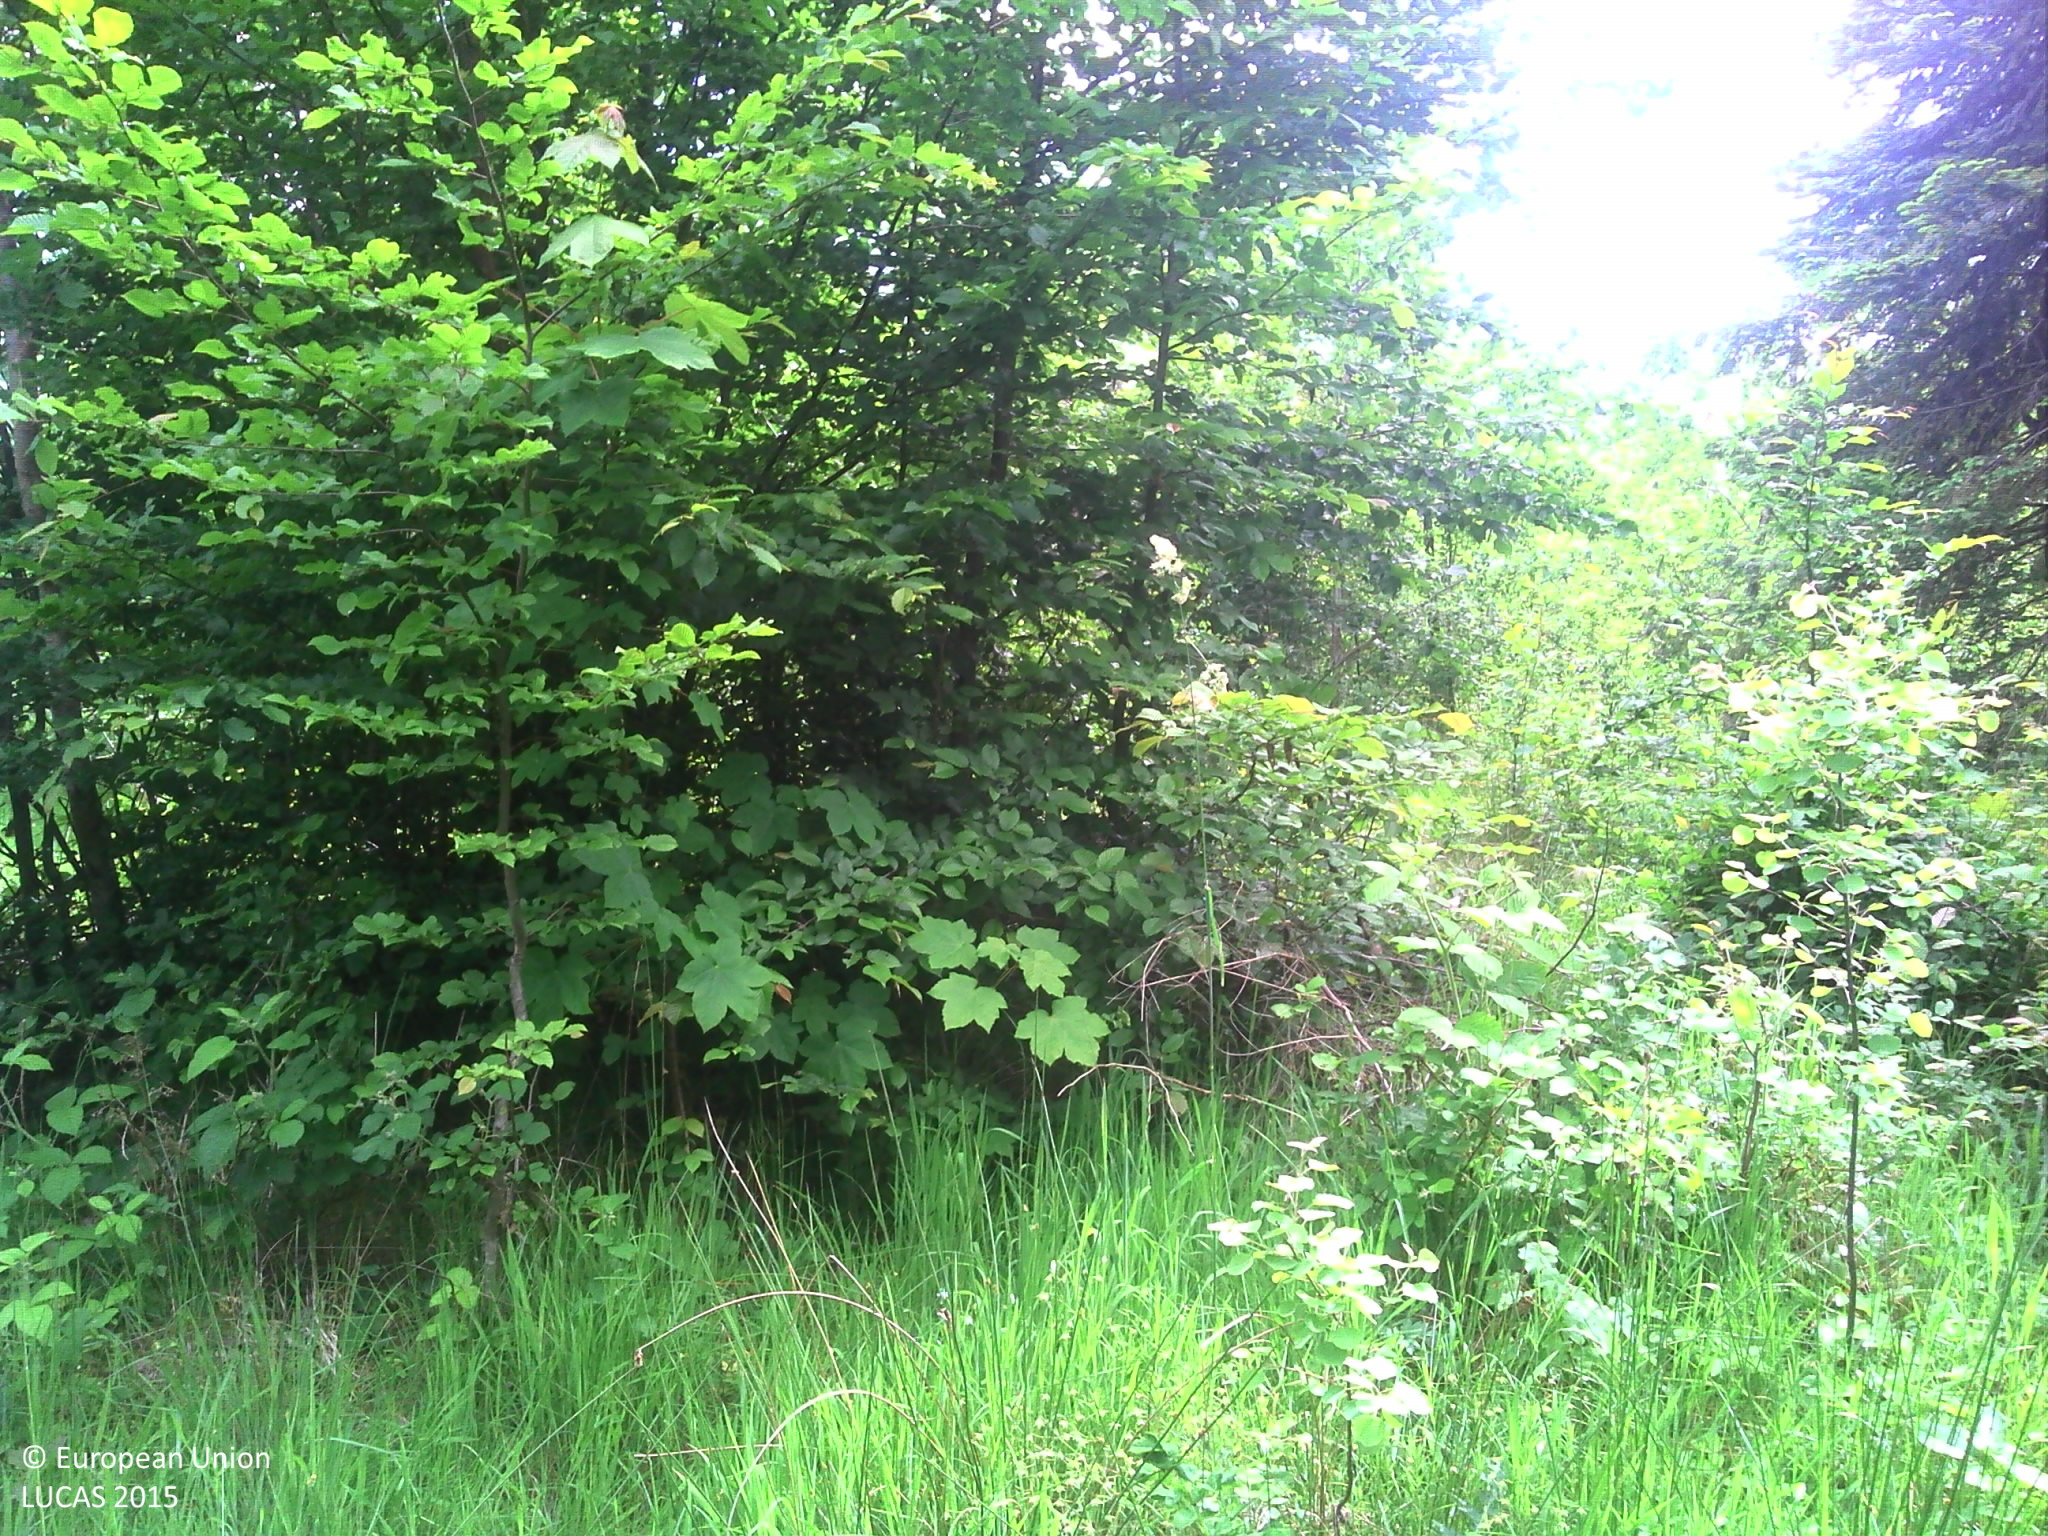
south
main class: Grassland
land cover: Grassland with sparse tree/shrub cover
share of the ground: > 75 %
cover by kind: herbaceous plants 95 %, broadleaved forest trees 5 %
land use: Semi-natural and natural areas not in use
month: June
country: FR
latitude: 48.5762
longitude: 4.9425
